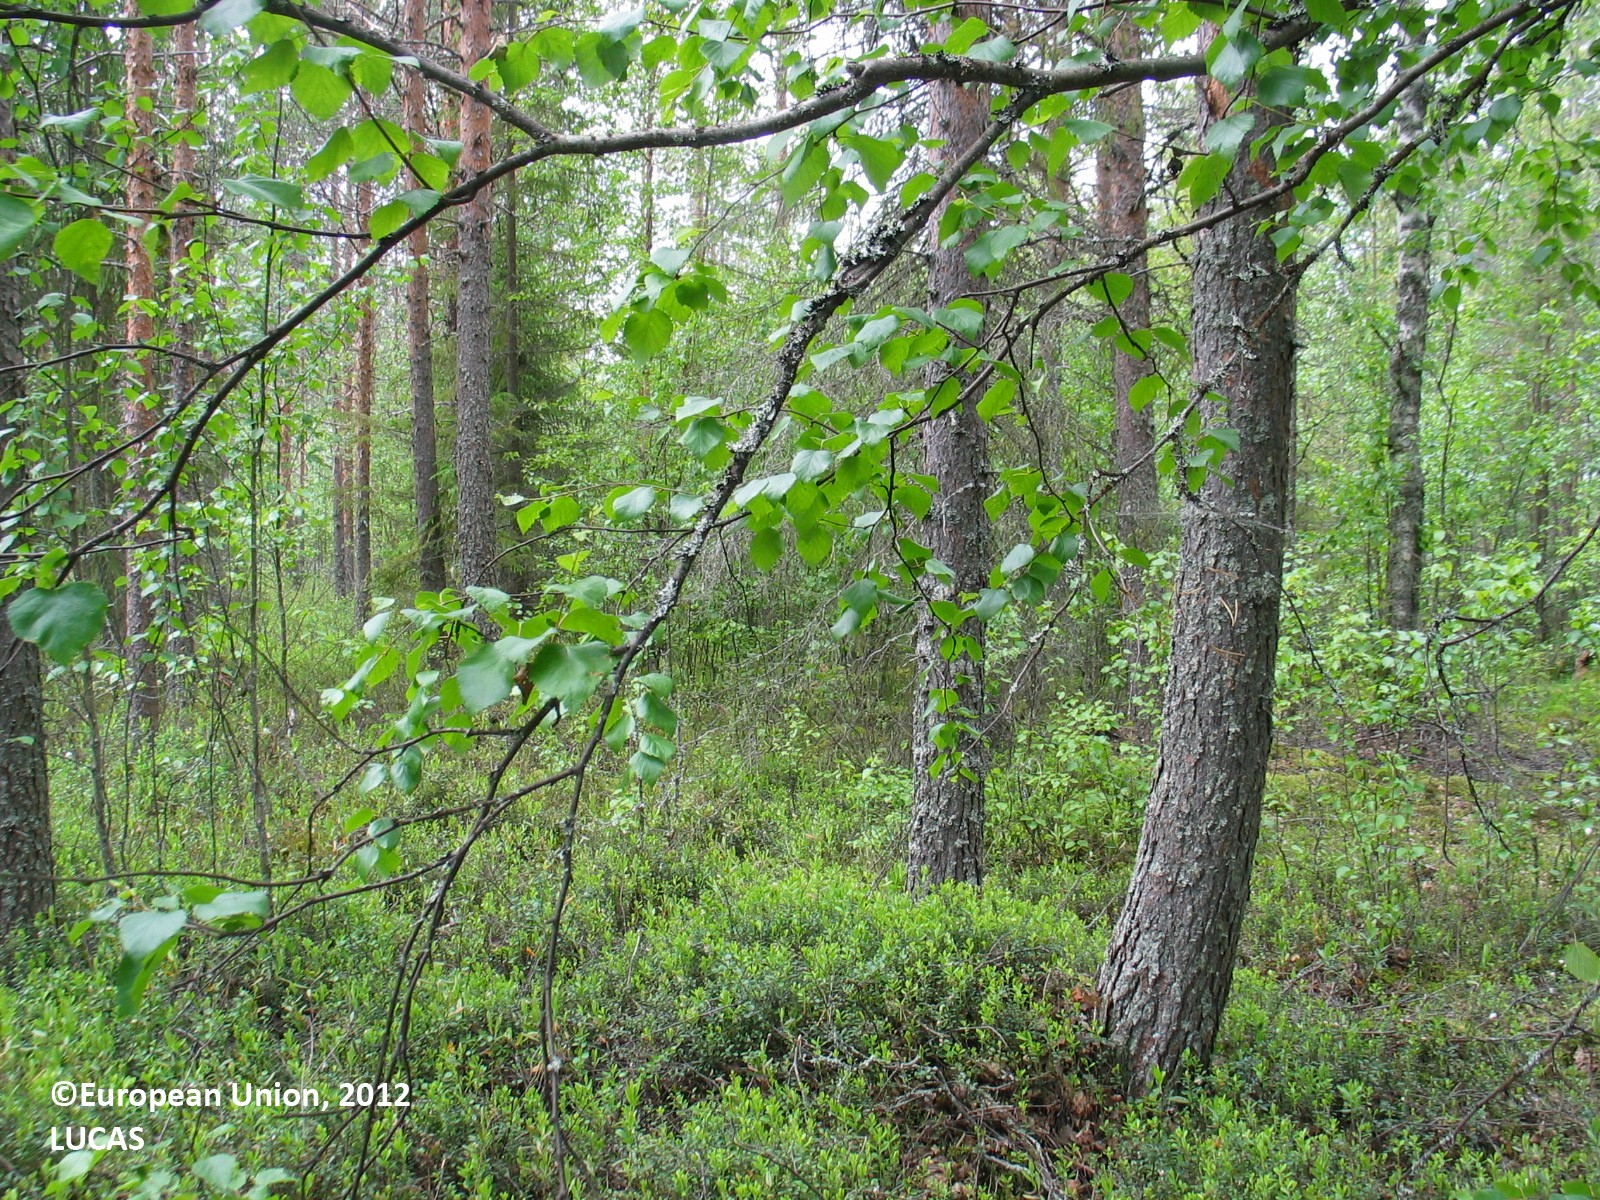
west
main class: Woodland
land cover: Other mixed woodland
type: boreal forest
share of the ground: 50 - 75 %
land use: Forestry
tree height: > 5 m
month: June
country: FI
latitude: 64.8257
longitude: 26.4809
